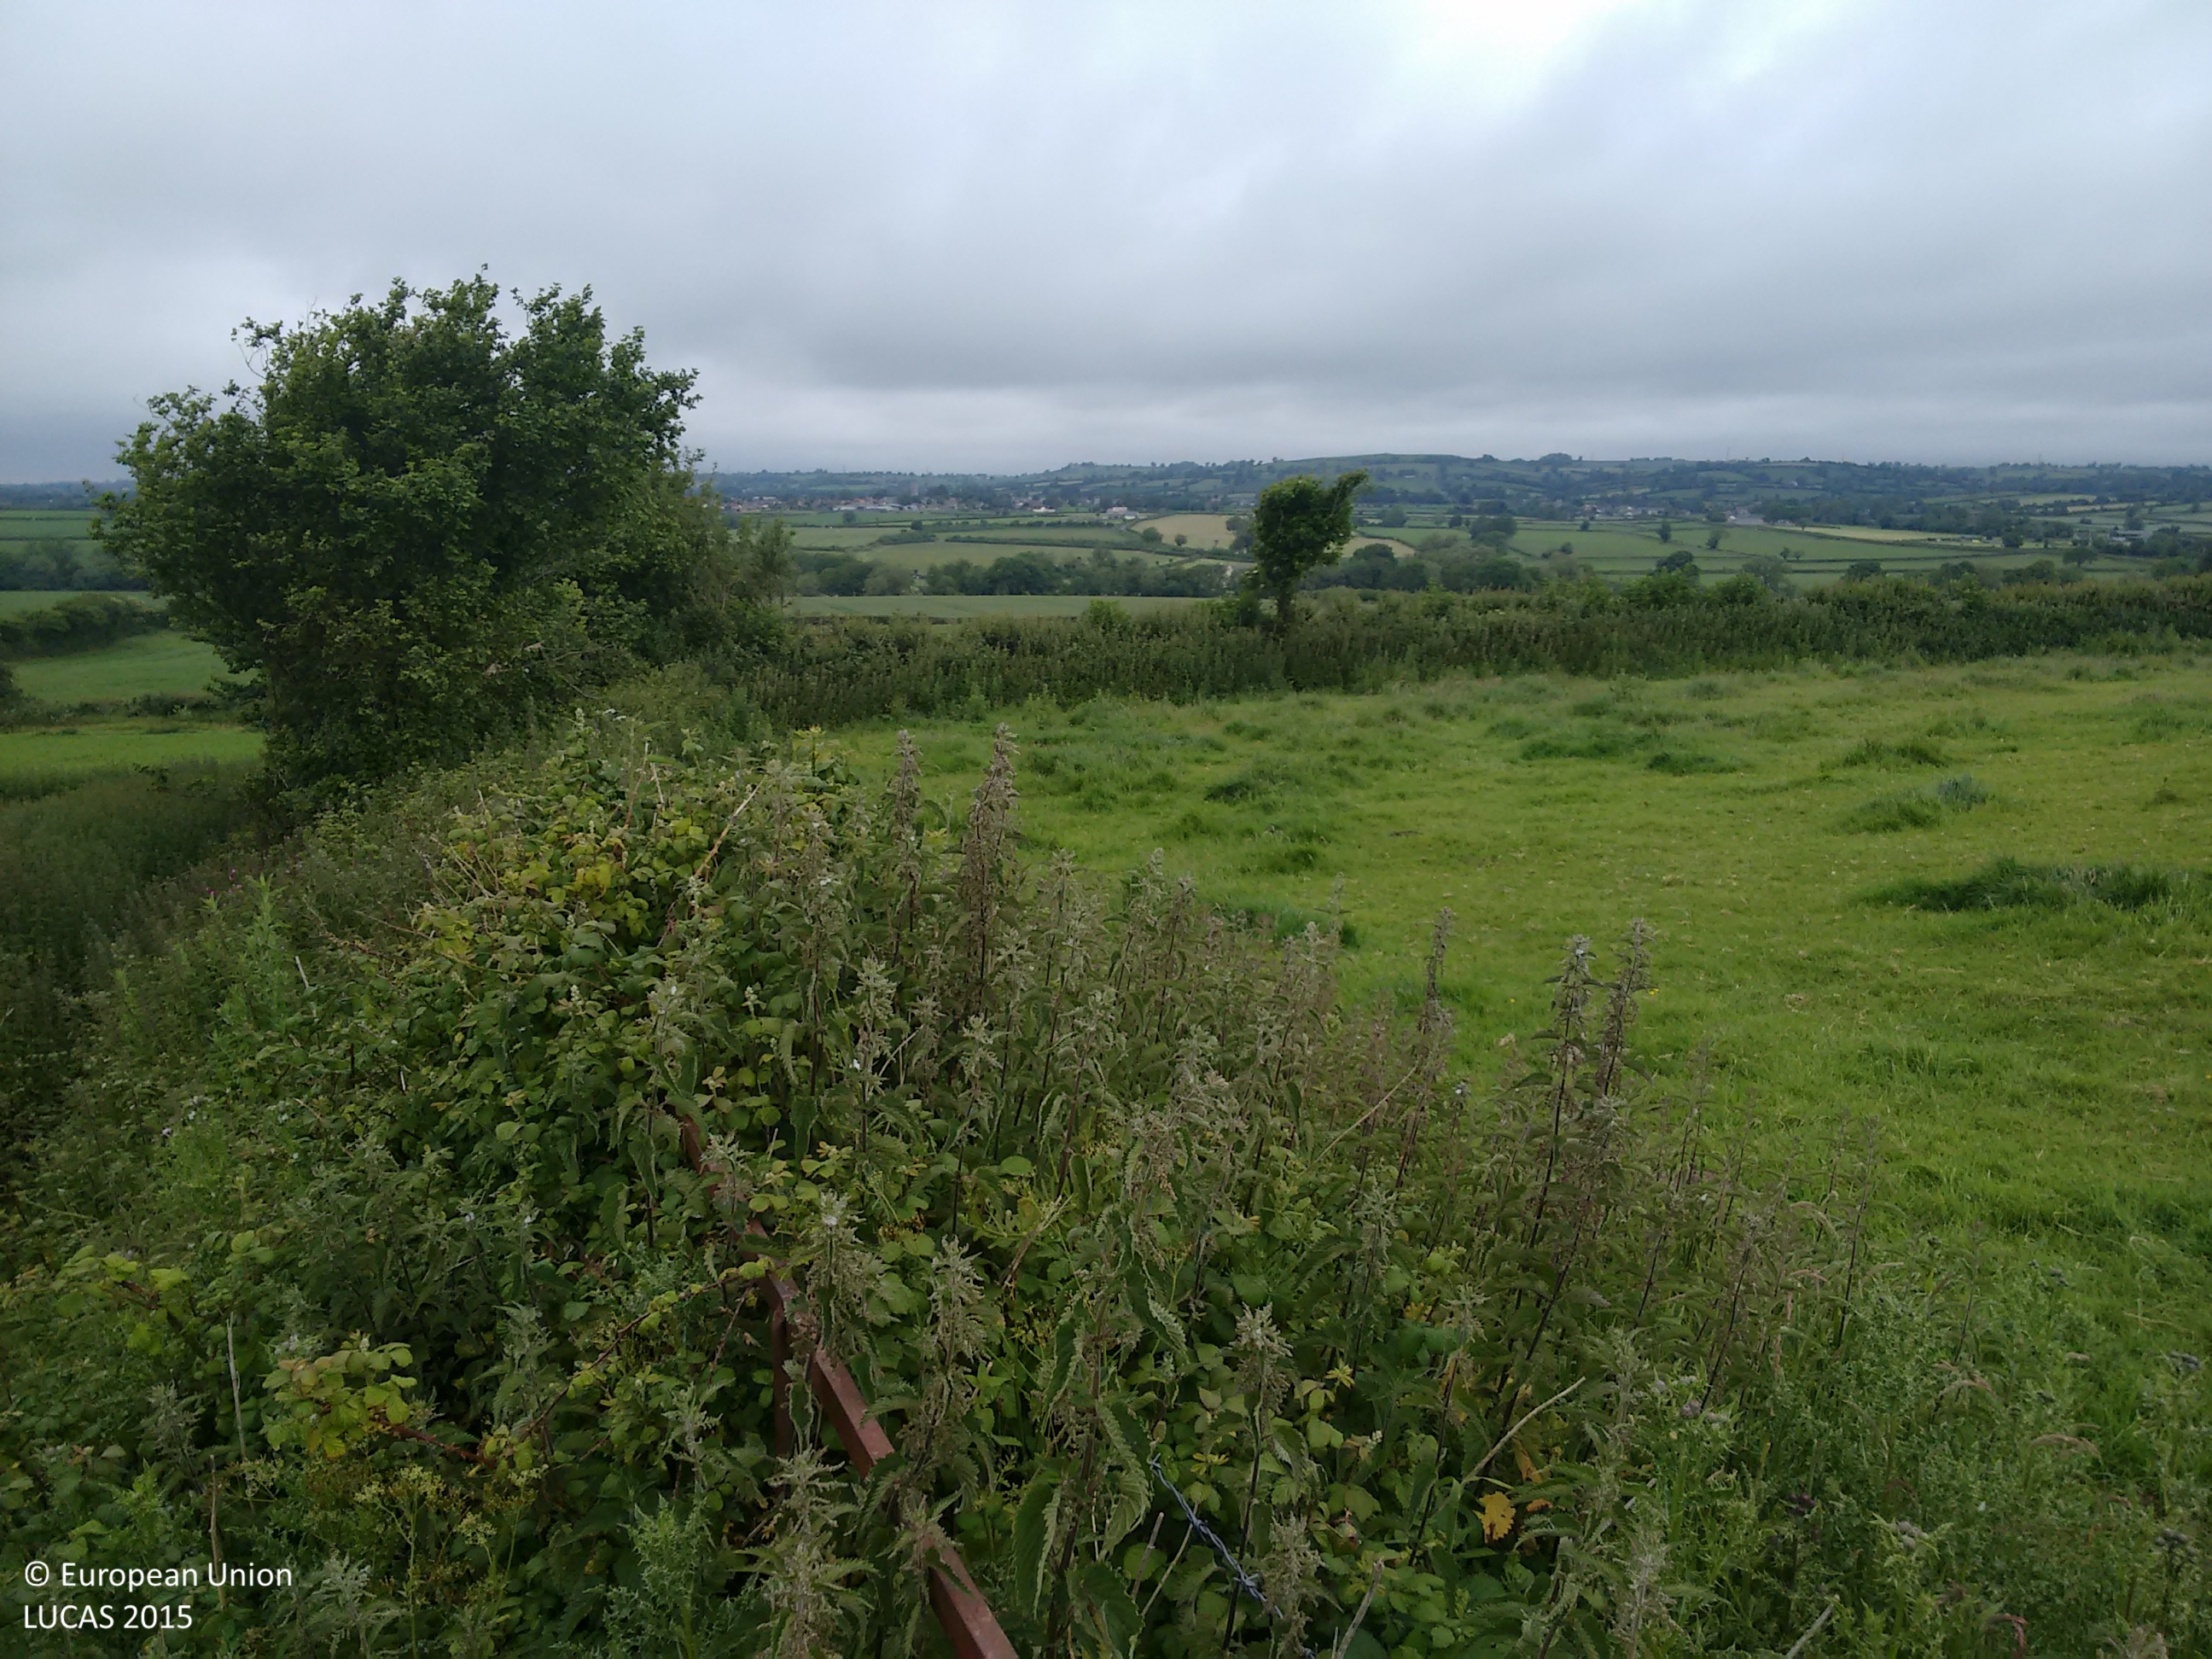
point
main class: Grassland
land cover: Grassland without tree/shrub cover
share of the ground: > 75 %
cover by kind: herbaceous plants 100 %
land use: Agriculture (excluding fallow land and kitchen gardens)
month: June
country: GB
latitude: 51.1328
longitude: -2.4847
